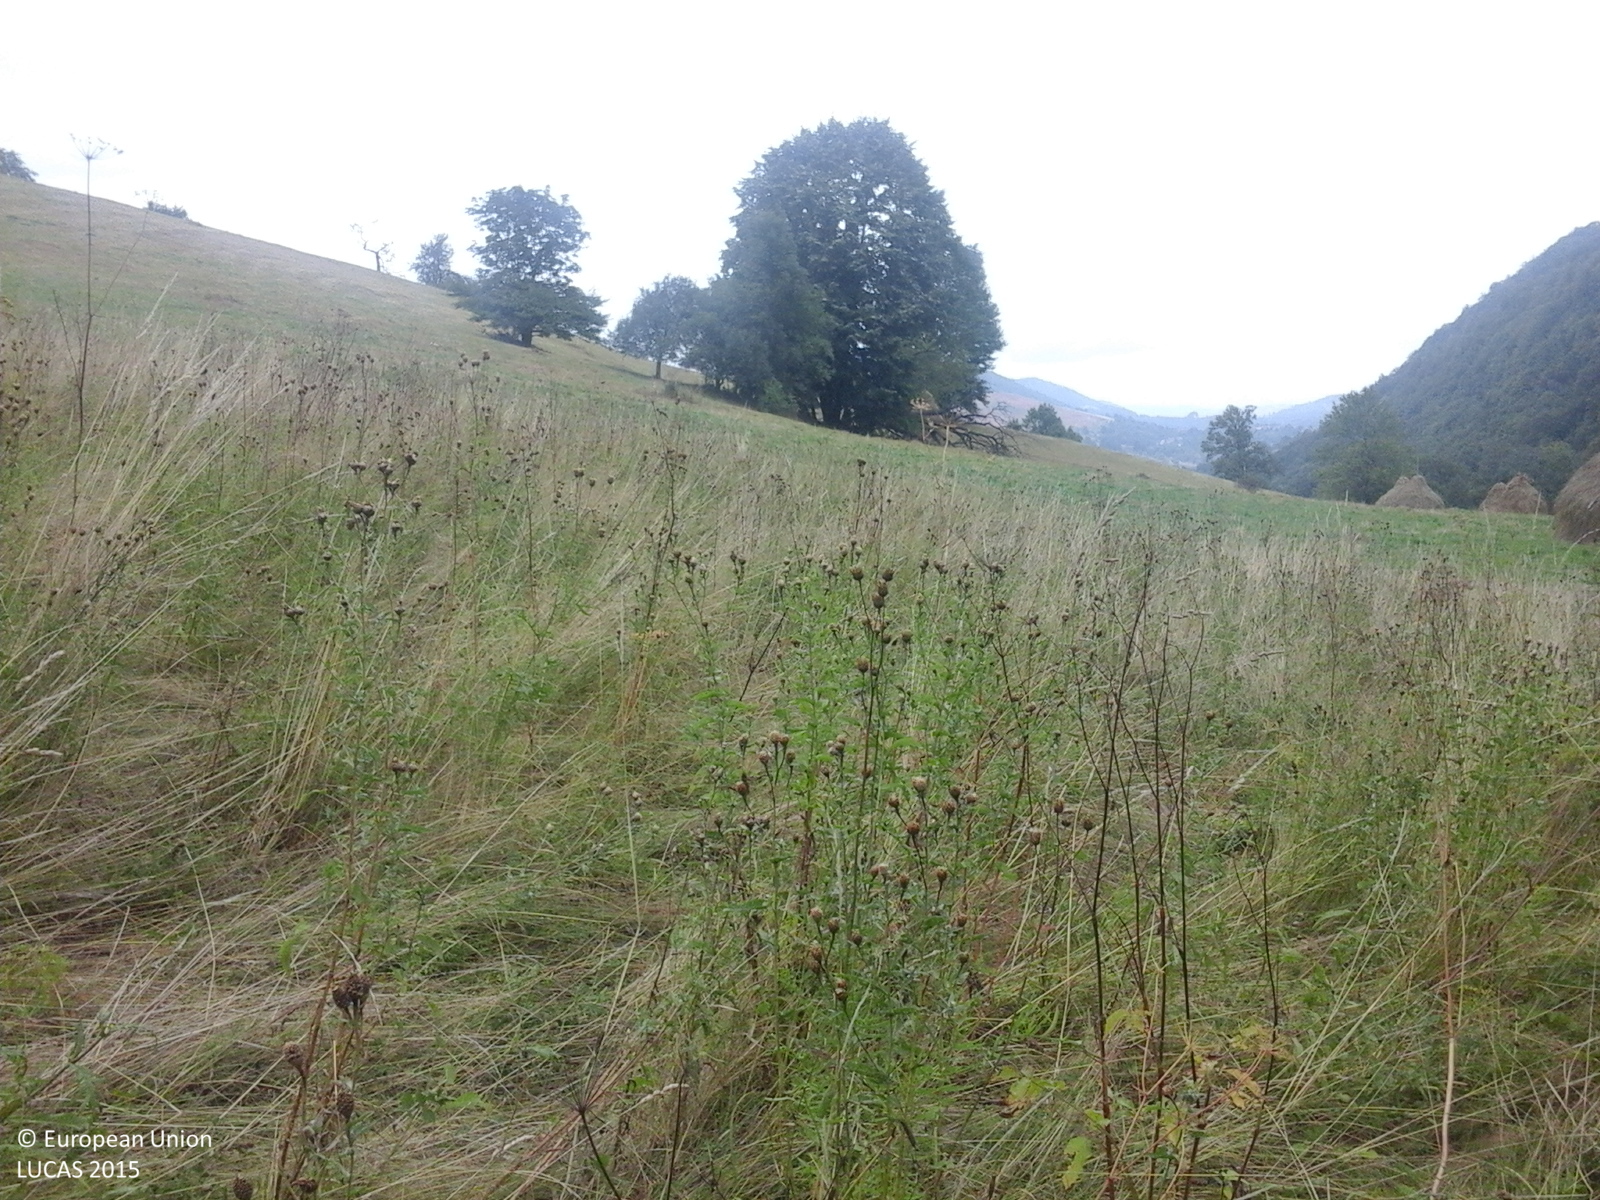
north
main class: Grassland
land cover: Grassland without tree/shrub cover
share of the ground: > 75 %
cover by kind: herbaceous plants 100 %
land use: Agriculture (excluding fallow land and kitchen gardens)
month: August
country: RO
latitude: 45.2420
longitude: 21.9477
